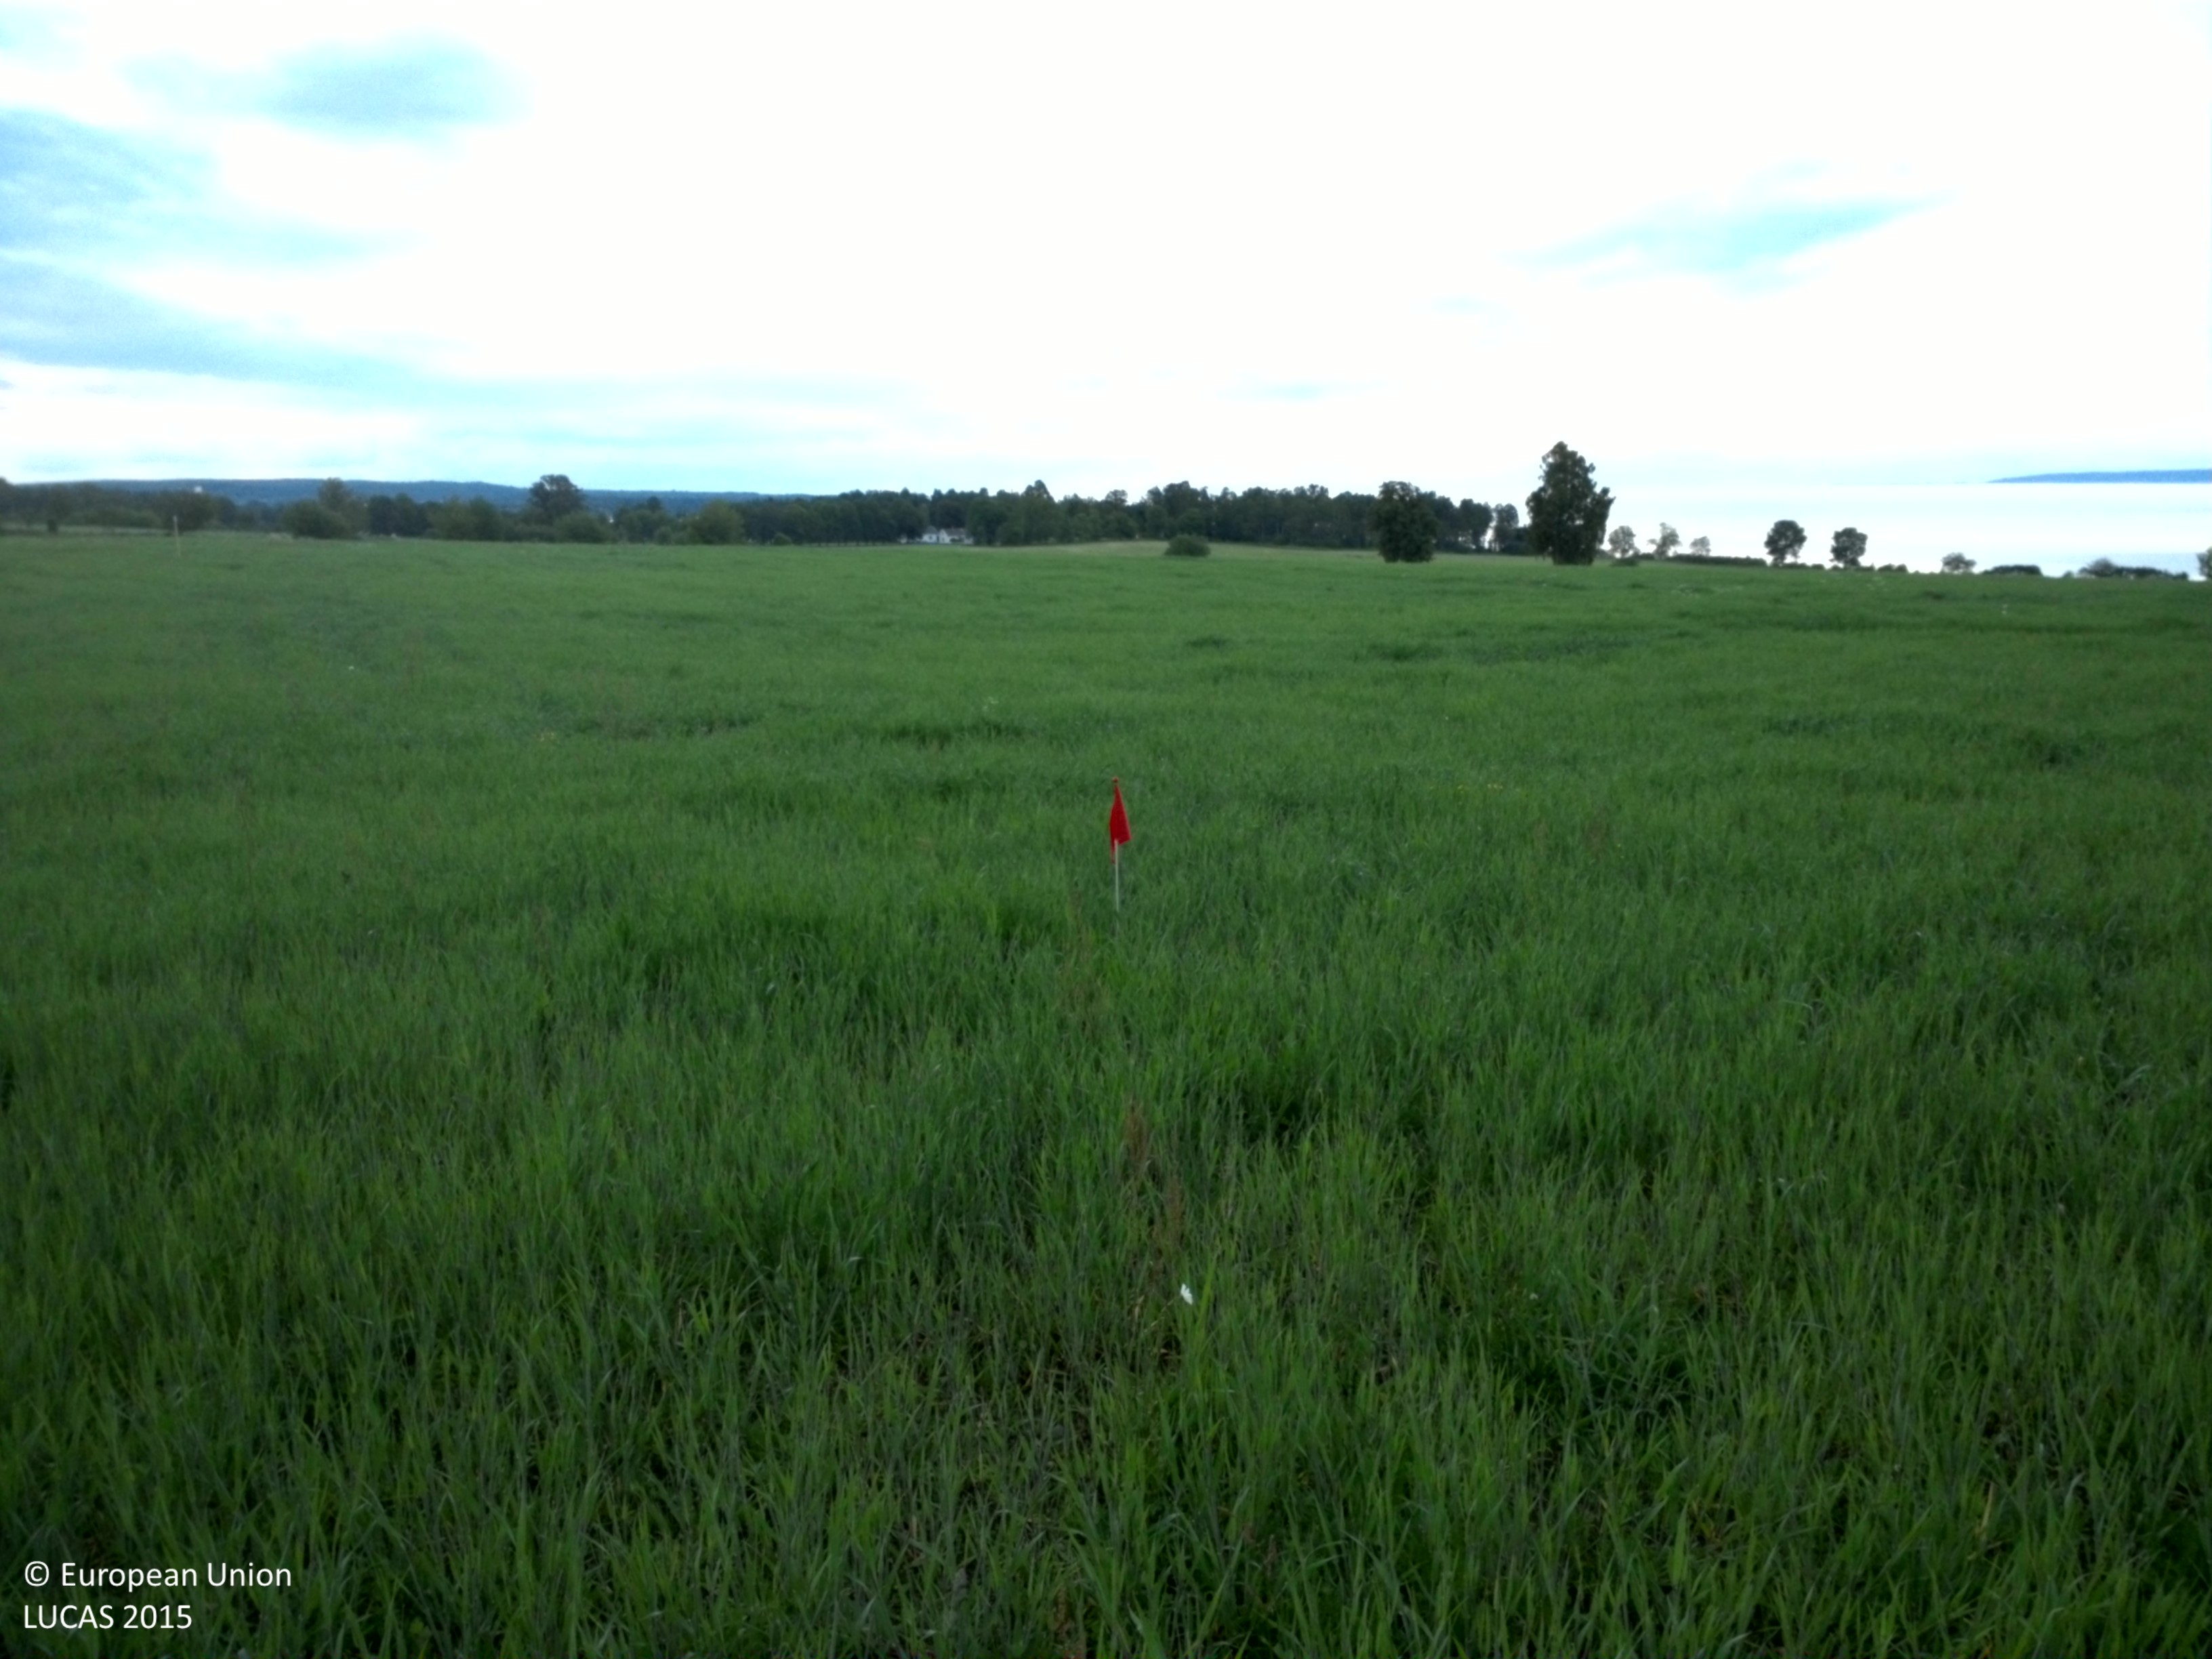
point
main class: Cropland
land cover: Barley
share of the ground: > 75 %
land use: Agriculture (excluding fallow land and kitchen gardens)
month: June
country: SE
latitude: 58.2777
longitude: 14.2739
